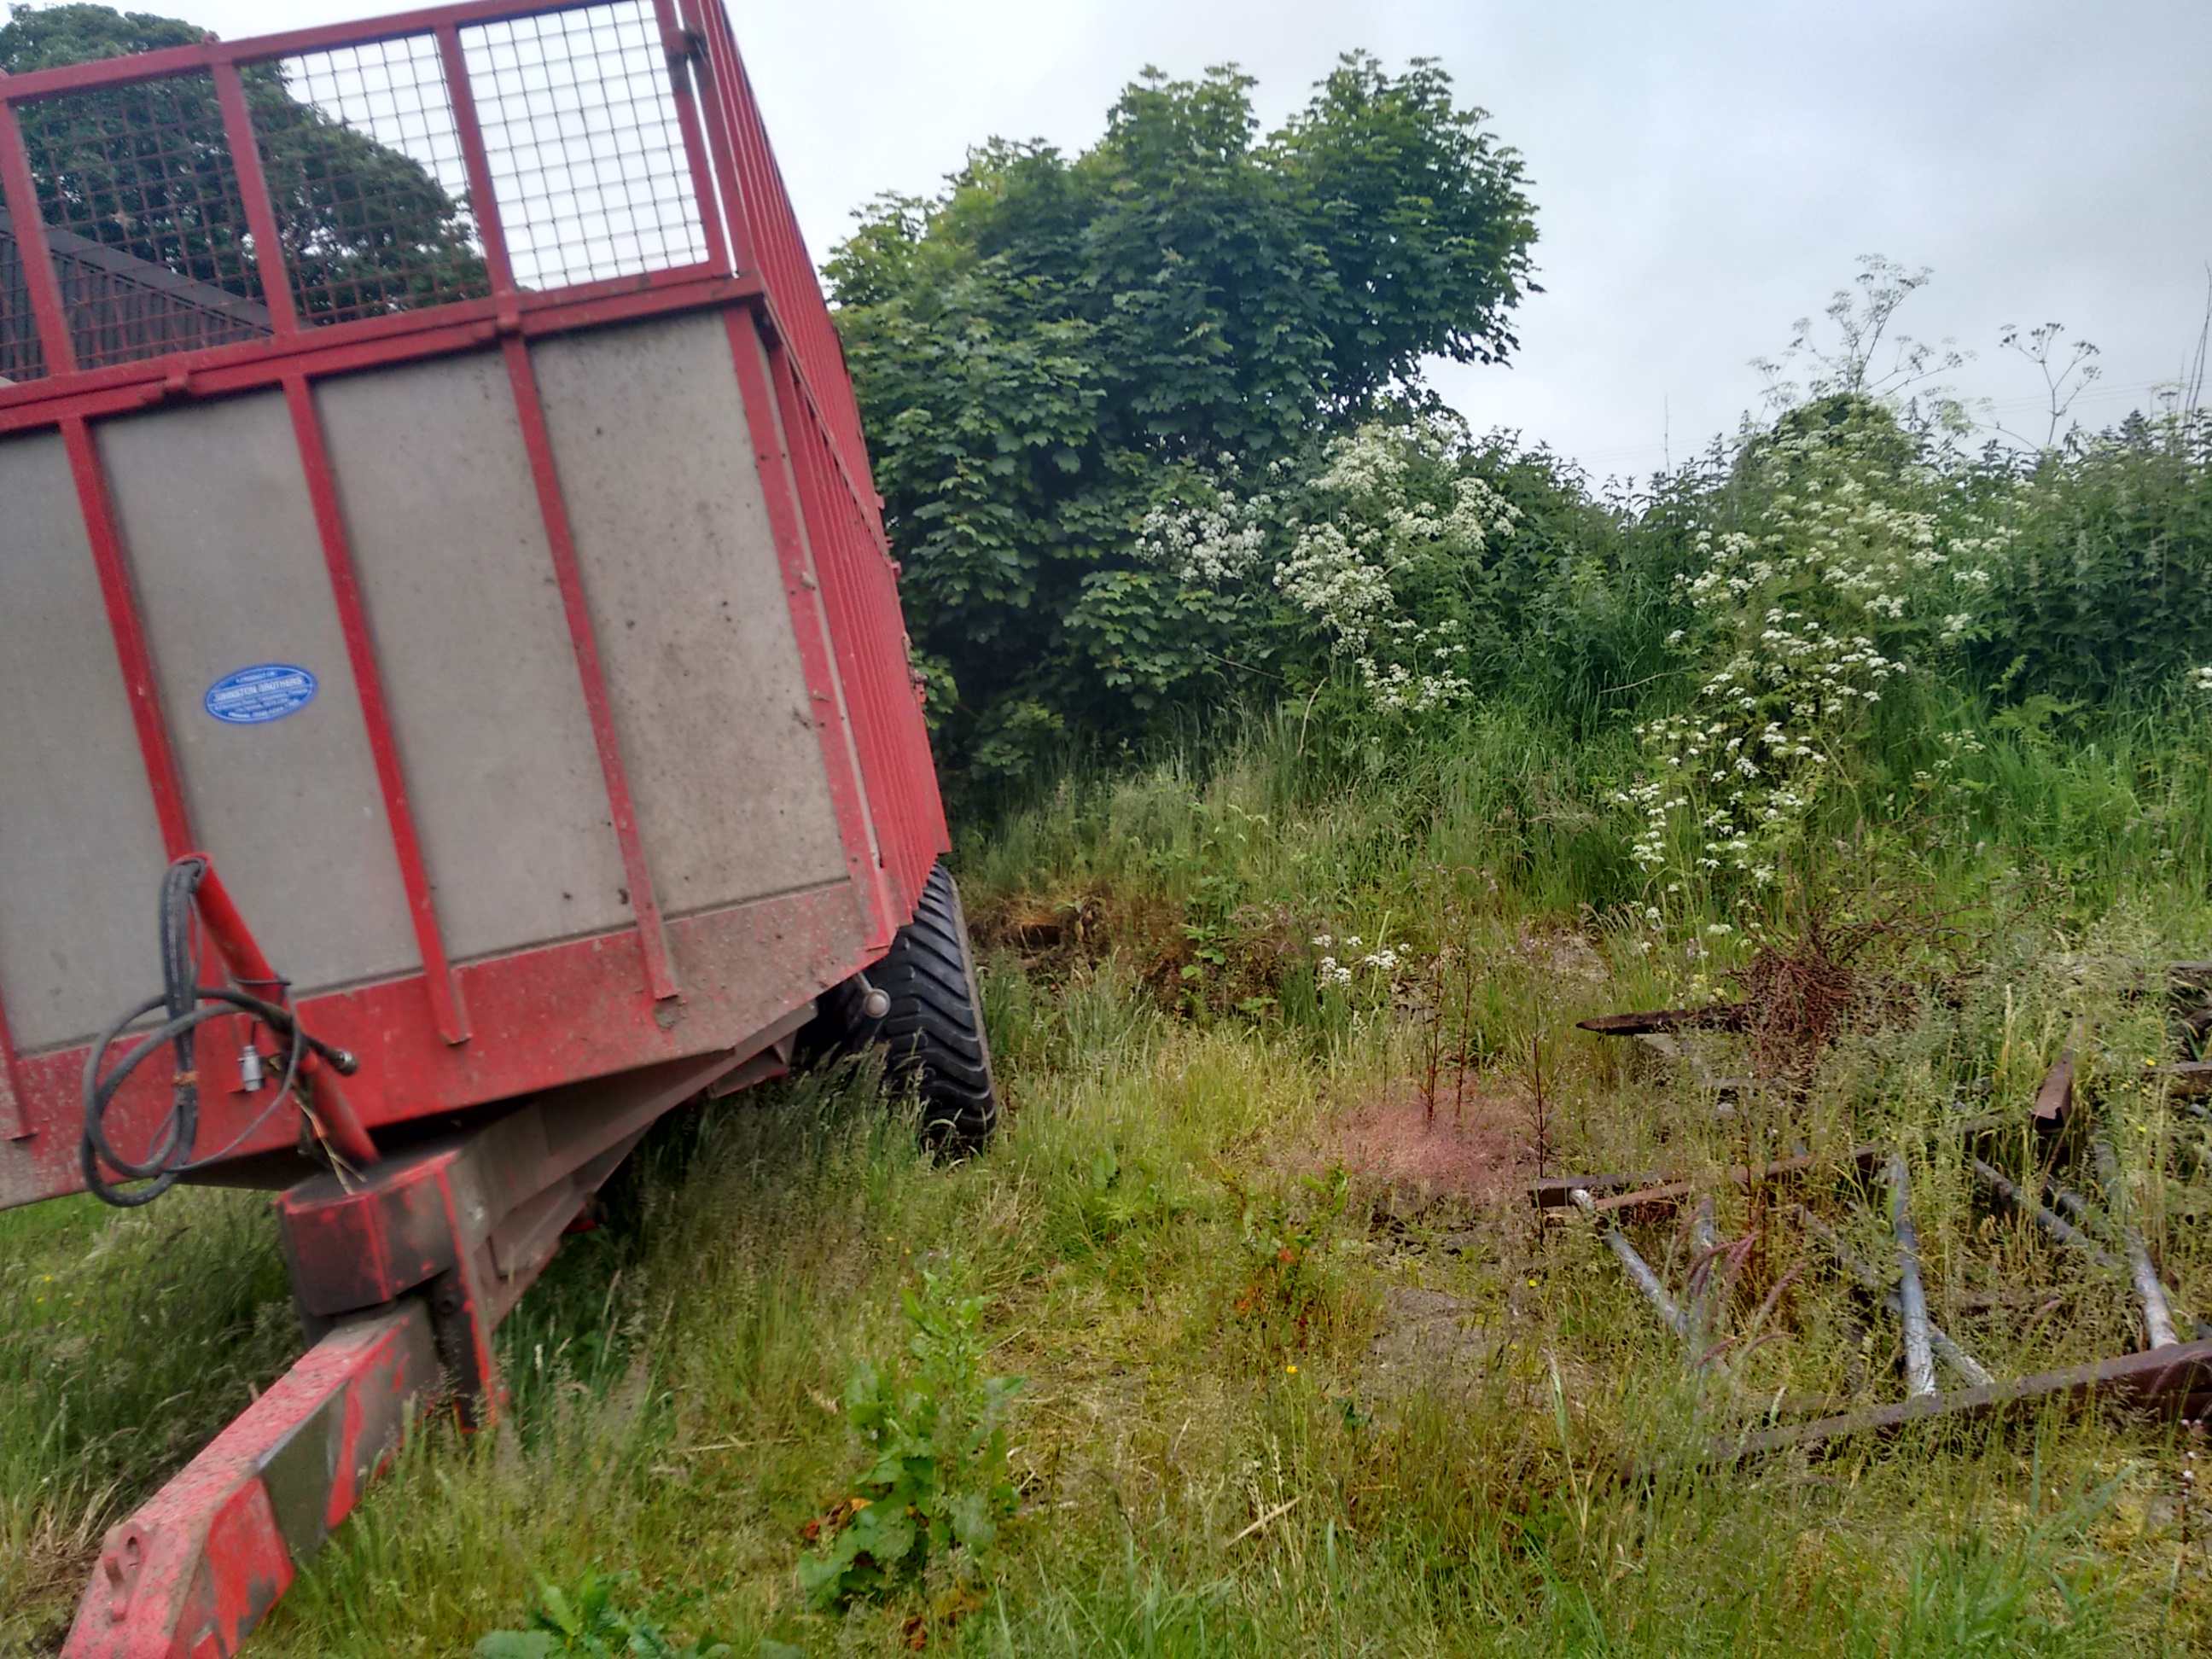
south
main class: Grassland
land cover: Grassland without tree/shrub cover
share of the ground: > 75 %
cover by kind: herbaceous plants 100 %
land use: Agriculture (excluding fallow land and kitchen gardens)
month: June
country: GB
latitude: 54.6783
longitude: -7.4781
